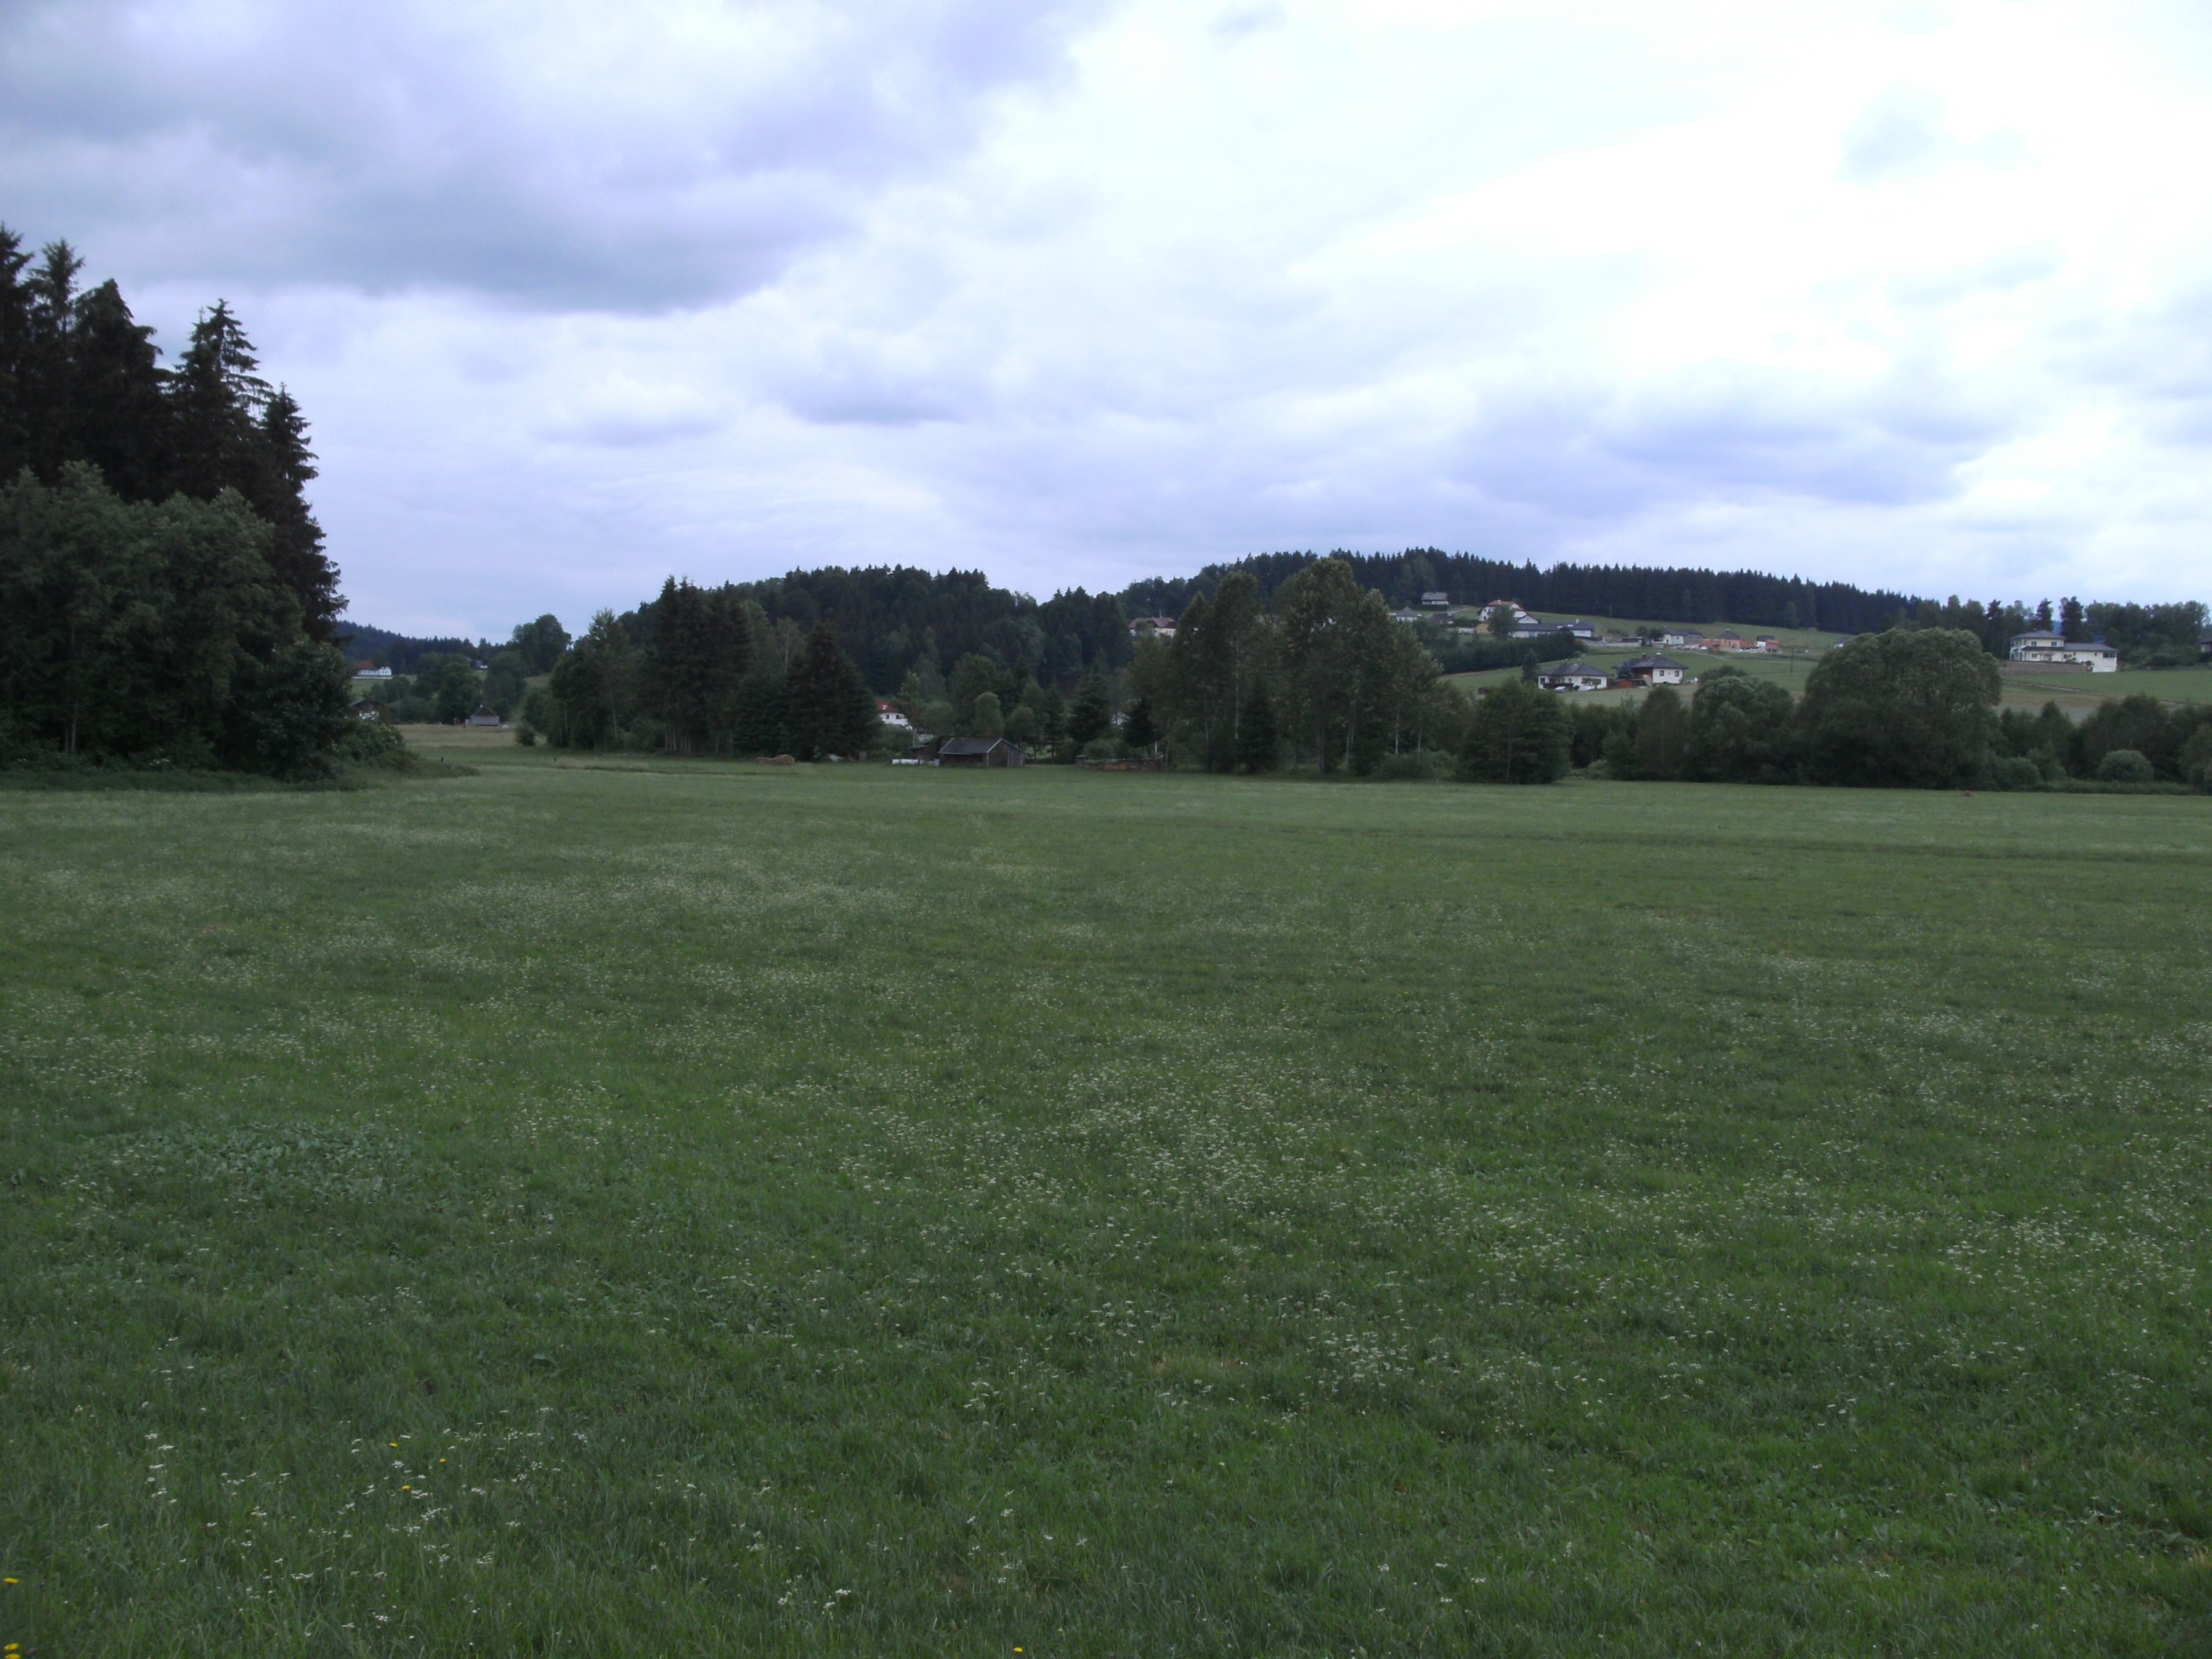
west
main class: Grassland
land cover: Grassland without tree/shrub cover
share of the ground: > 75 %
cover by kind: herbaceous plants 100 %
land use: Agriculture (excluding fallow land and kitchen gardens)
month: June
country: AT
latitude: 48.5585
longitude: 14.1870
